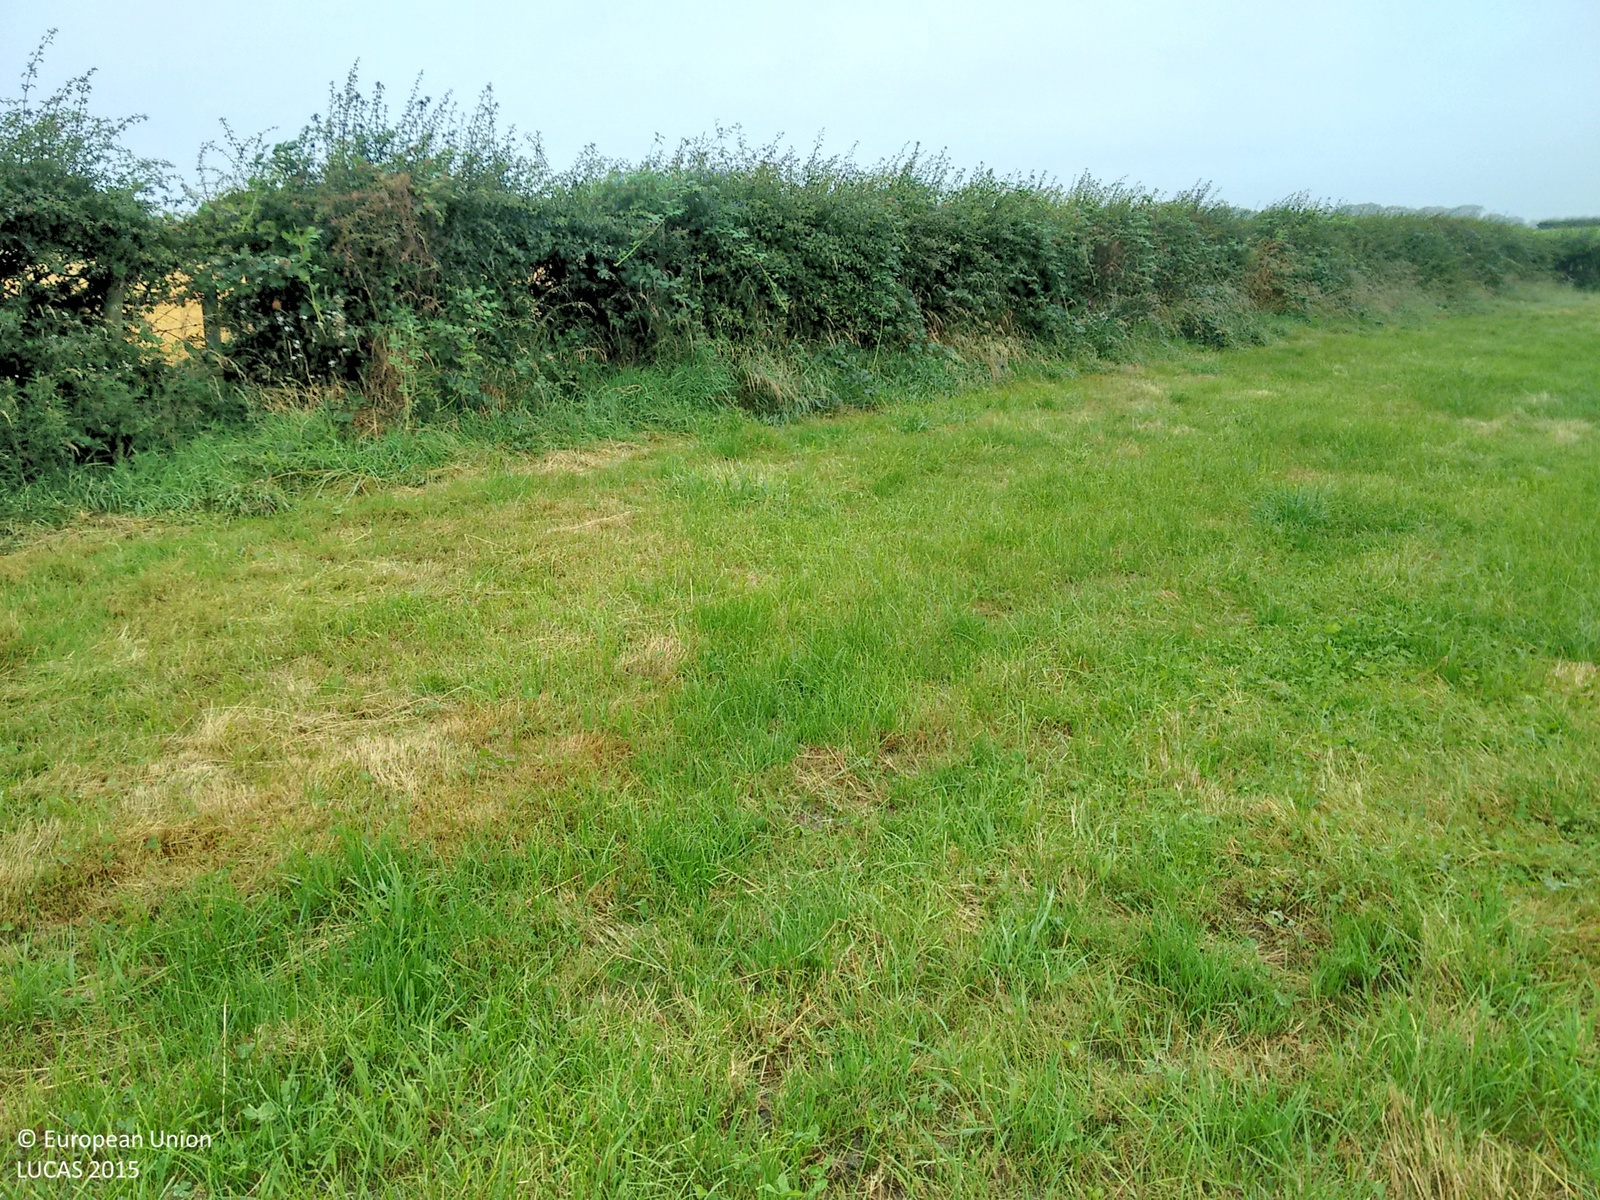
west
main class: Grassland
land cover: Grassland without tree/shrub cover
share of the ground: > 75 %
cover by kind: herbaceous plants 100 %
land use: Agriculture (excluding fallow land and kitchen gardens)
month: August
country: GB
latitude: 54.2852
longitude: -5.6304
